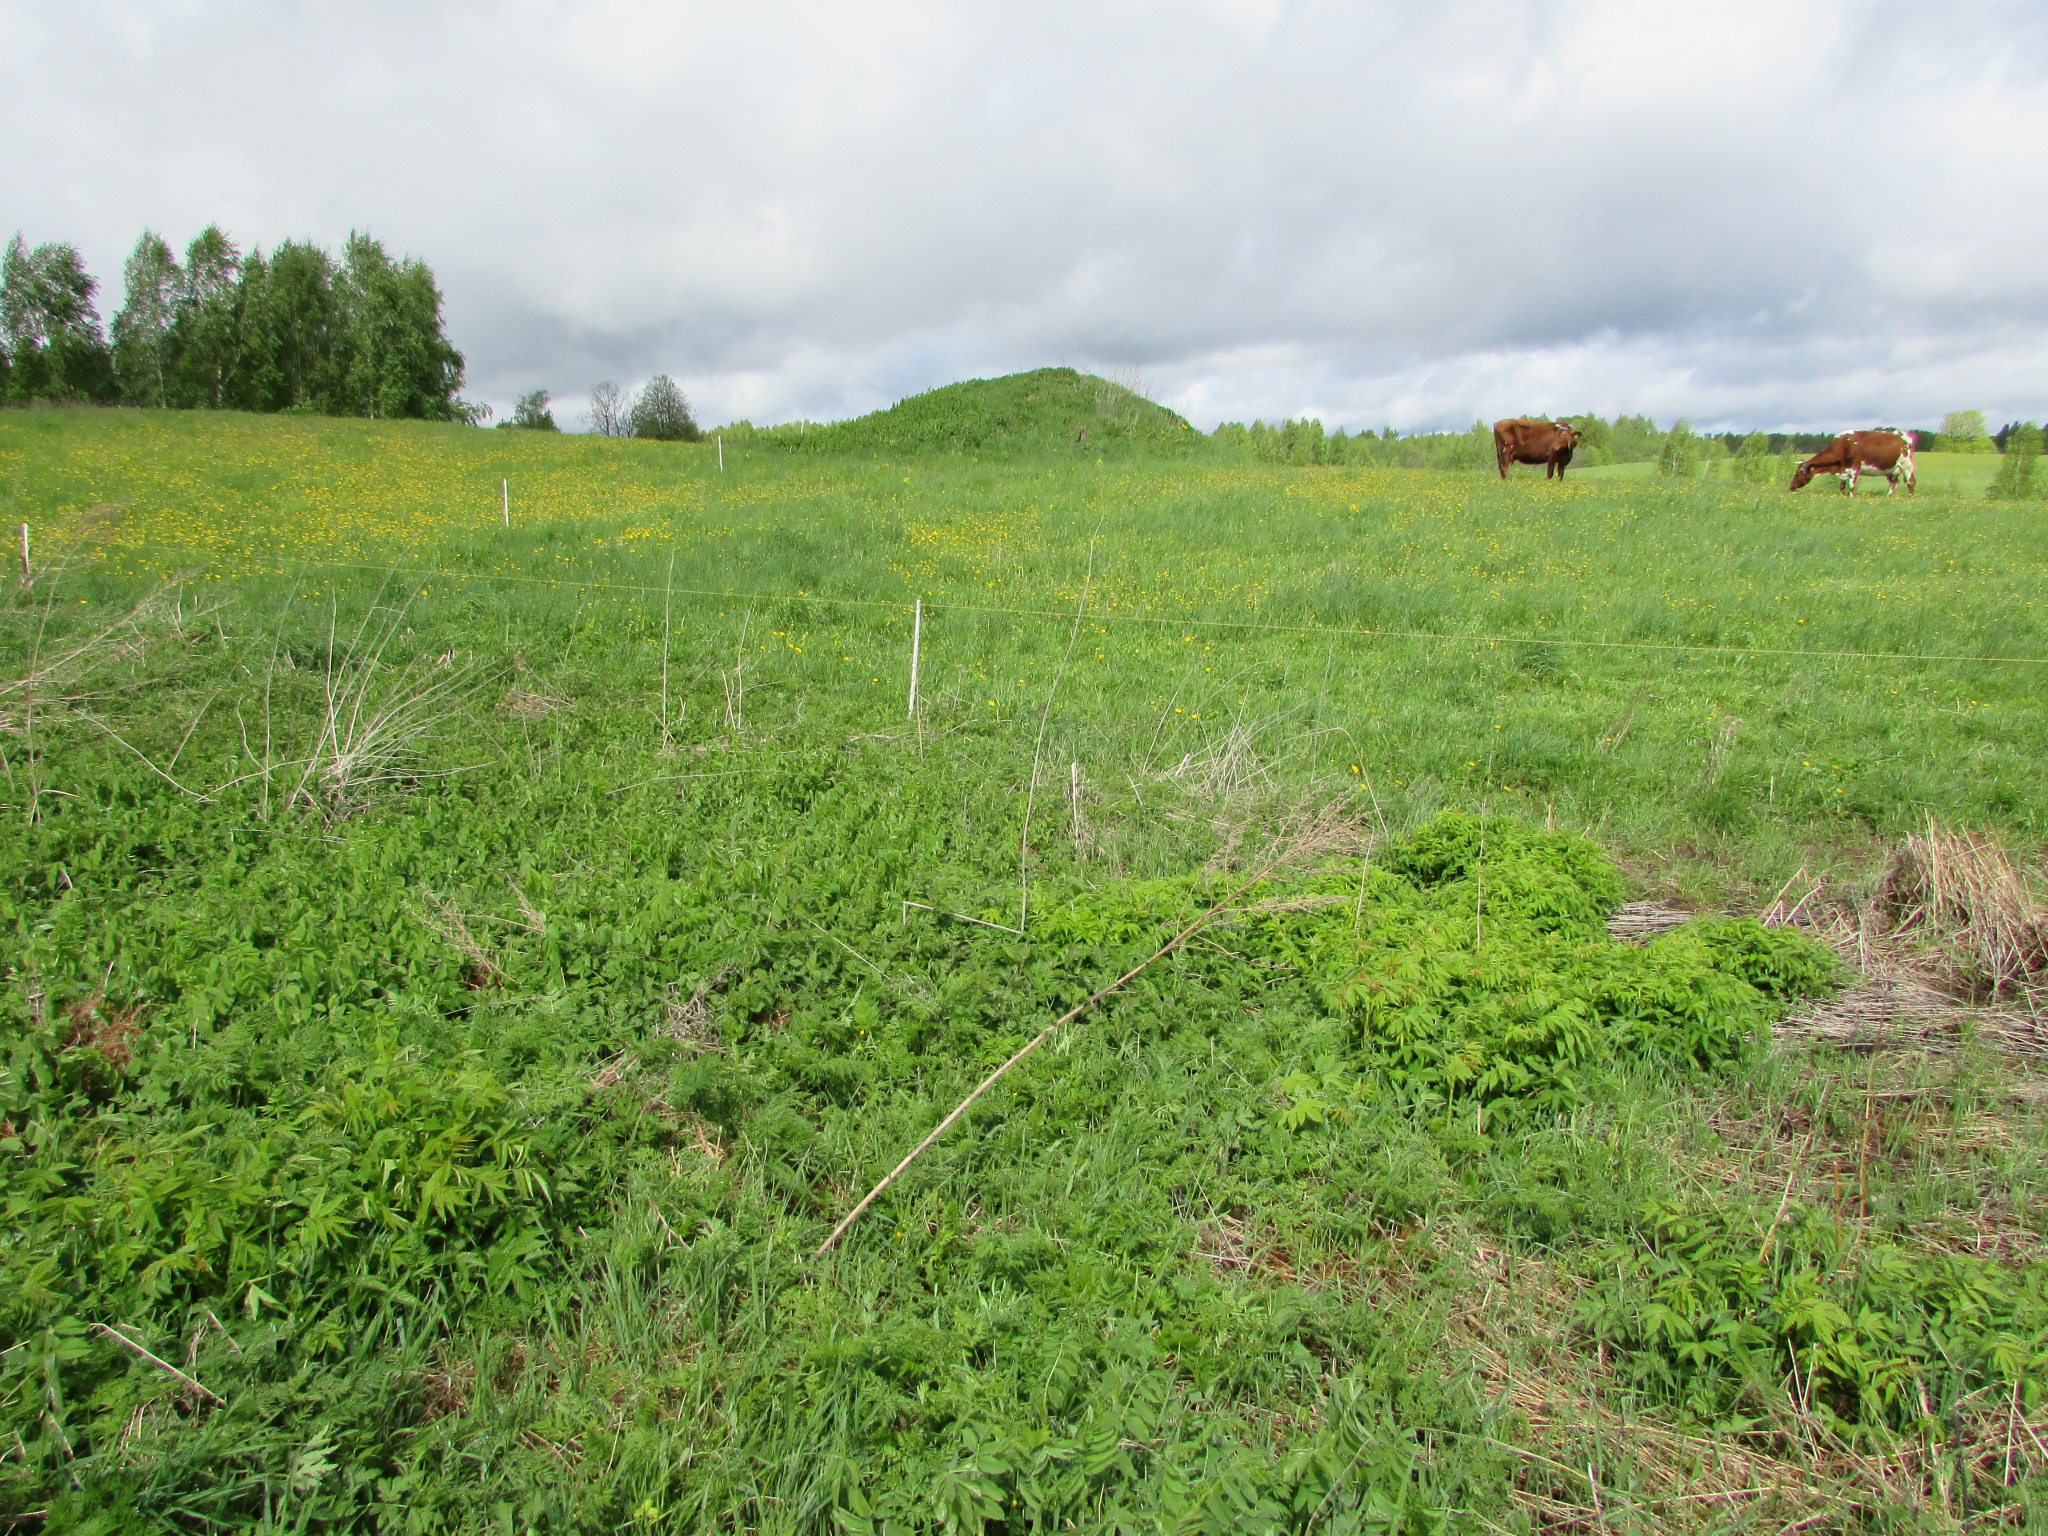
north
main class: Grassland
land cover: Grassland without tree/shrub cover
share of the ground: > 75 %
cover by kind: herbaceous plants 100 %
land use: Agriculture (excluding fallow land and kitchen gardens)
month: May
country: LV
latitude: 56.1318
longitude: 27.3767
